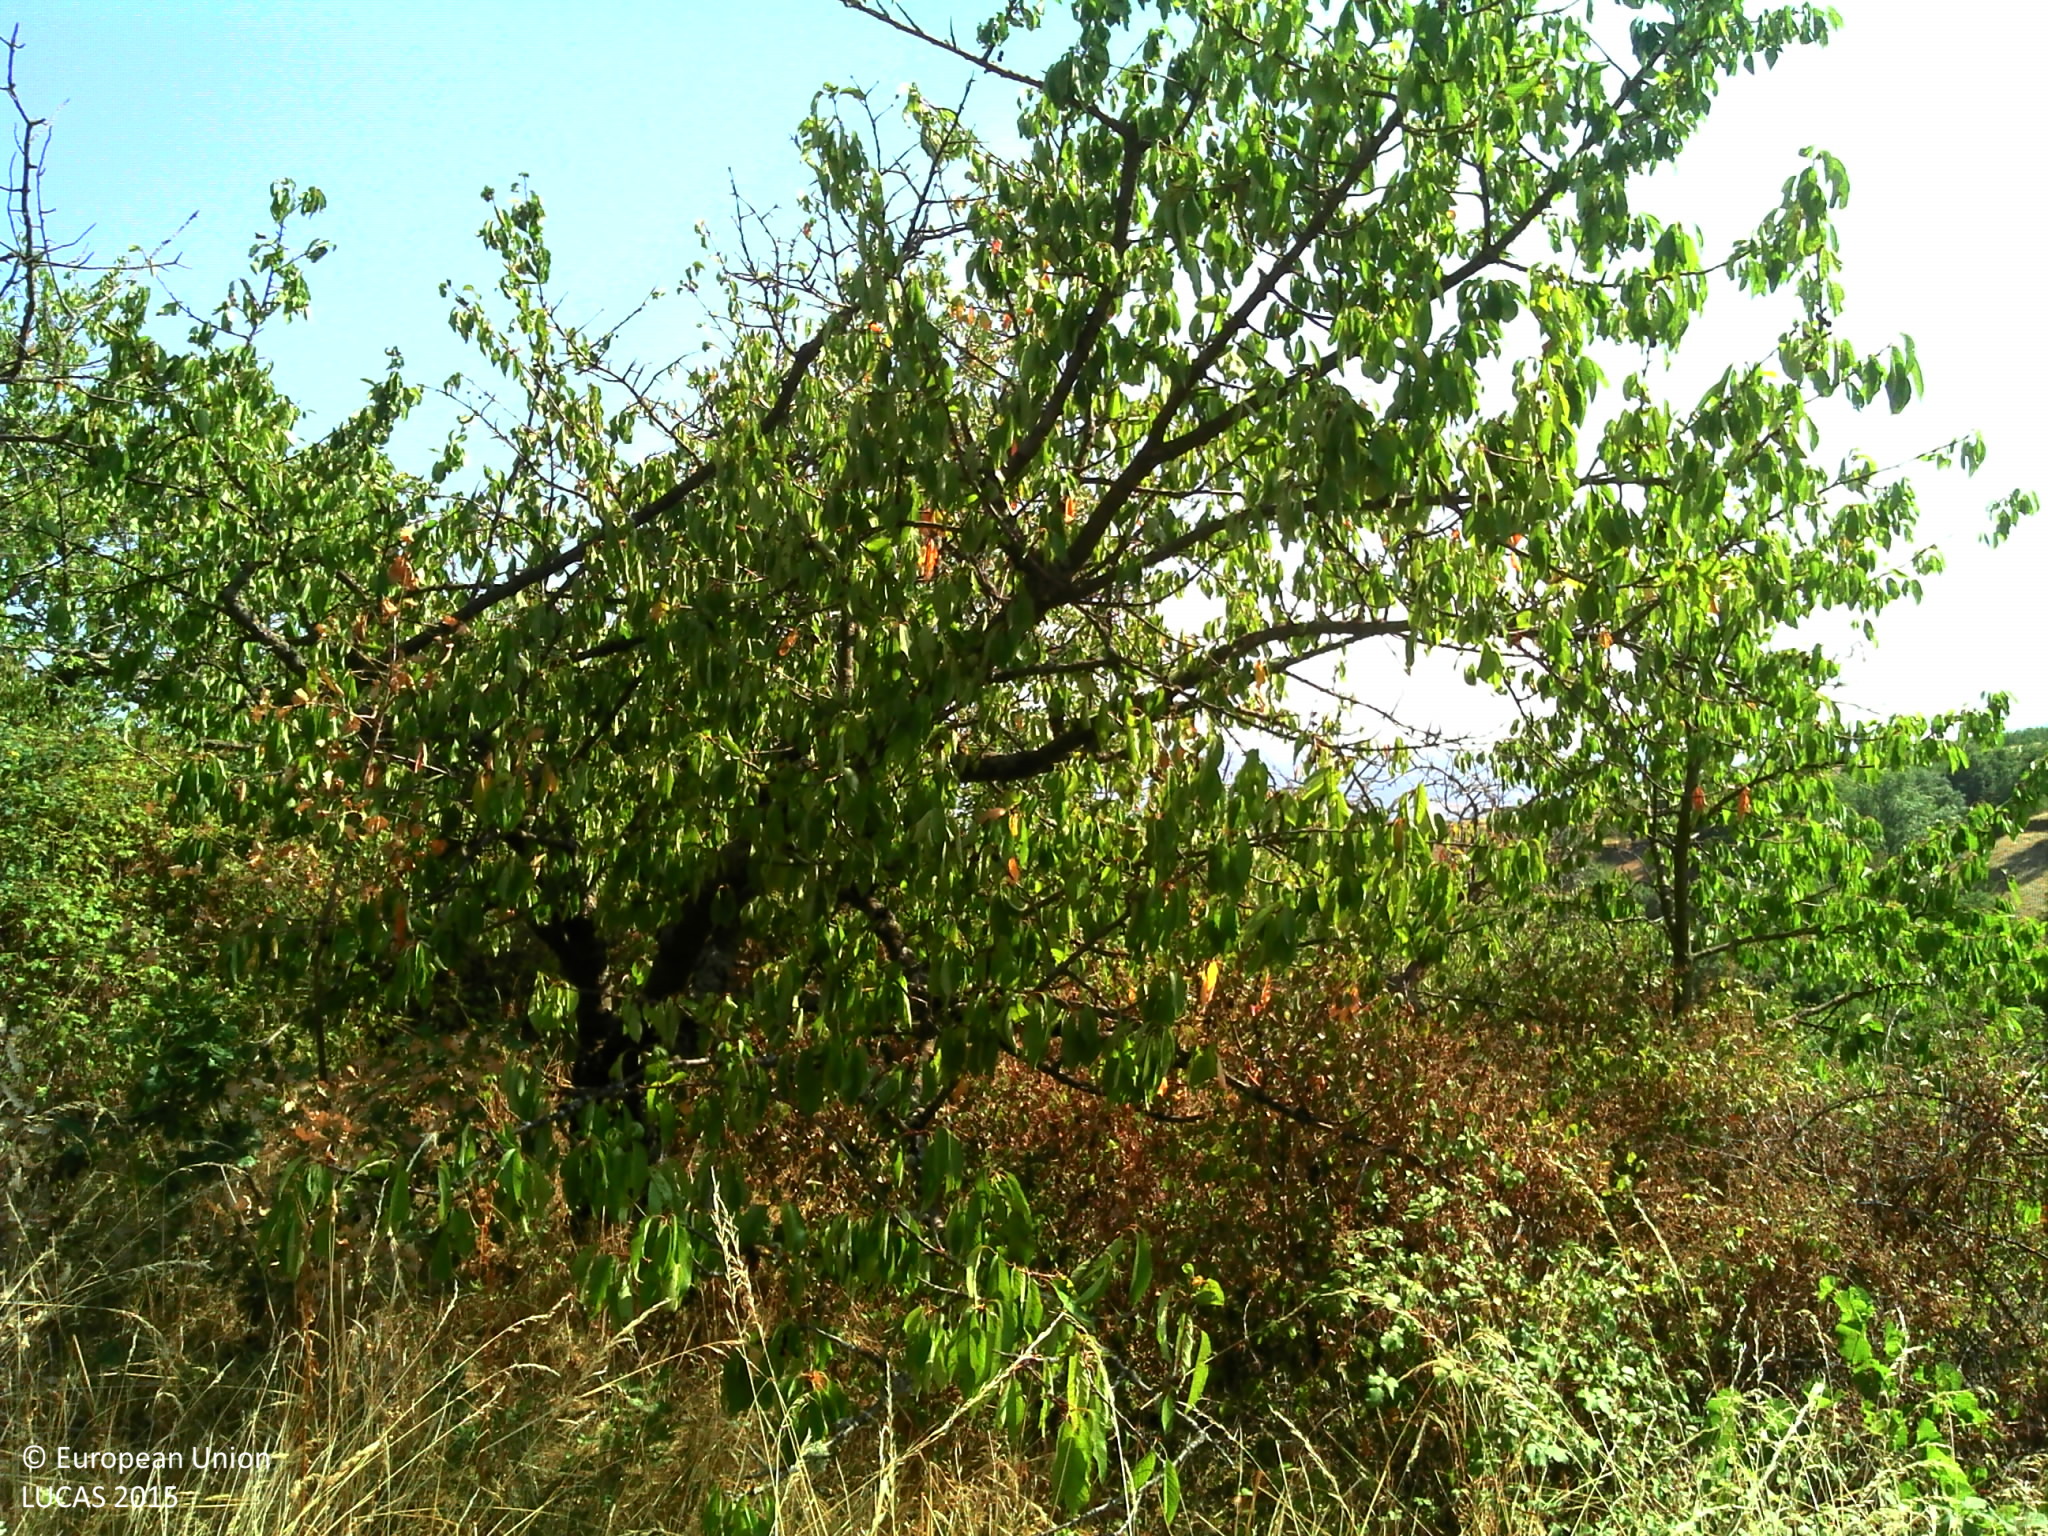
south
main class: Cropland
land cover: Apple fruit
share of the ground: 10 - 25 %
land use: Agriculture (excluding fallow land and kitchen gardens)
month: August
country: FR
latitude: 45.5461
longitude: 4.5860
